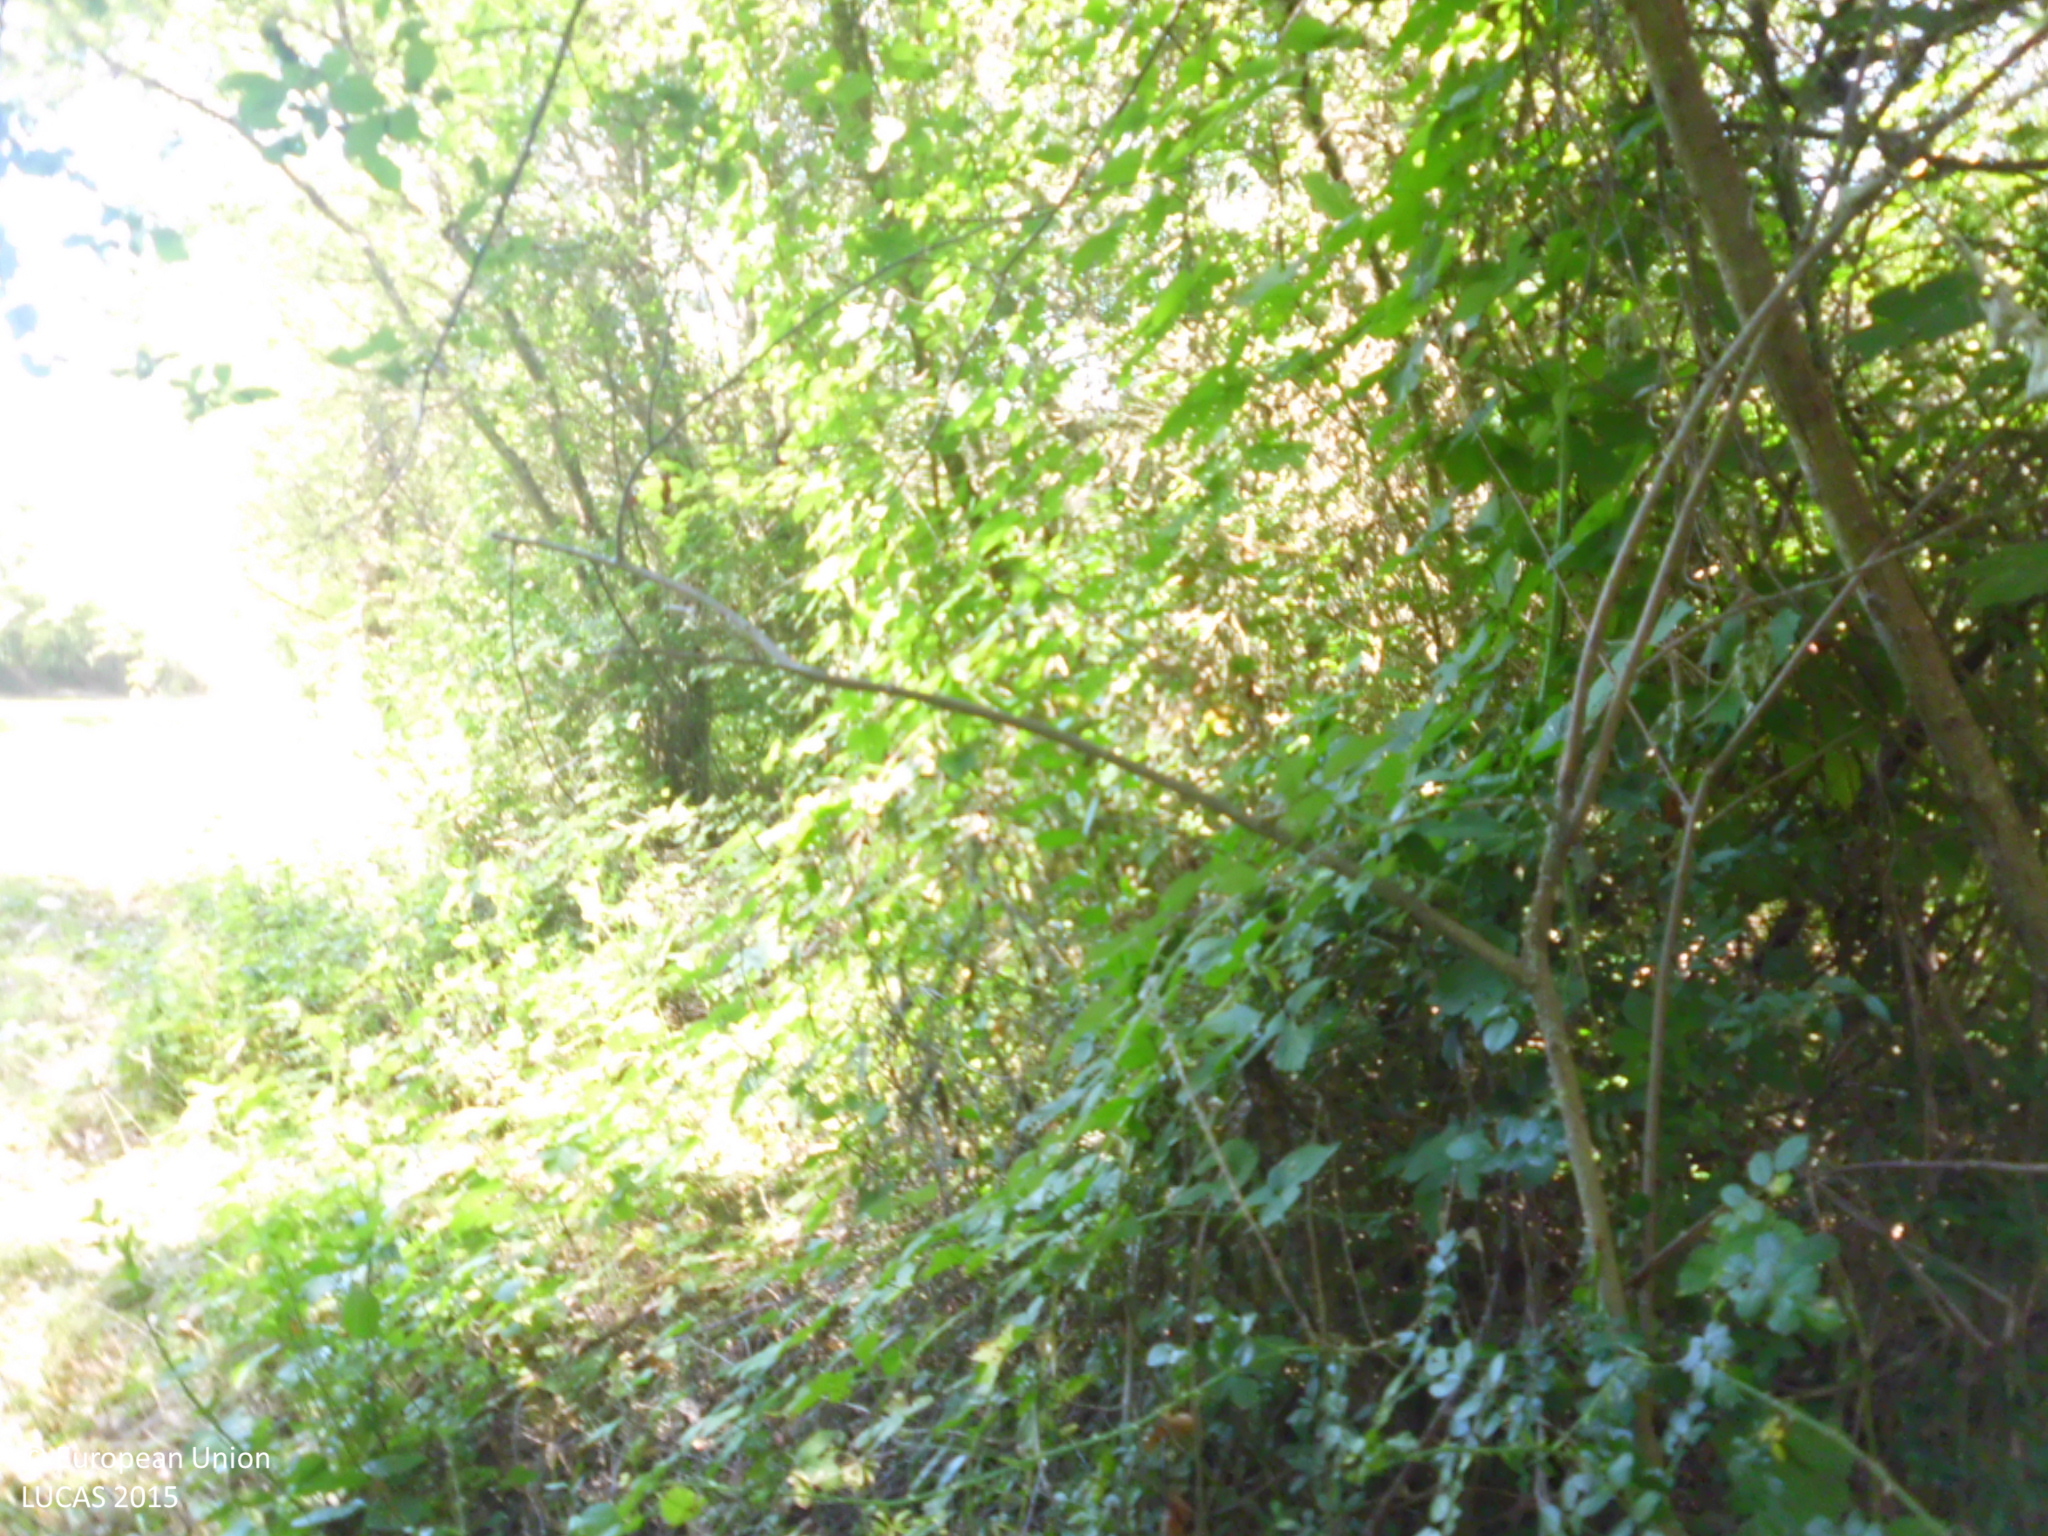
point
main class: Woodland
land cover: Broadleaved woodland
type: acidophilous oak and oak-birch forest
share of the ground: > 75 %
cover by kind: broadleaved forest trees 95 %, shrubs 5 %
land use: Semi-natural and natural areas not in use
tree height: > 5 m
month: July
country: ES
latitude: 42.3091
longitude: -3.3883
